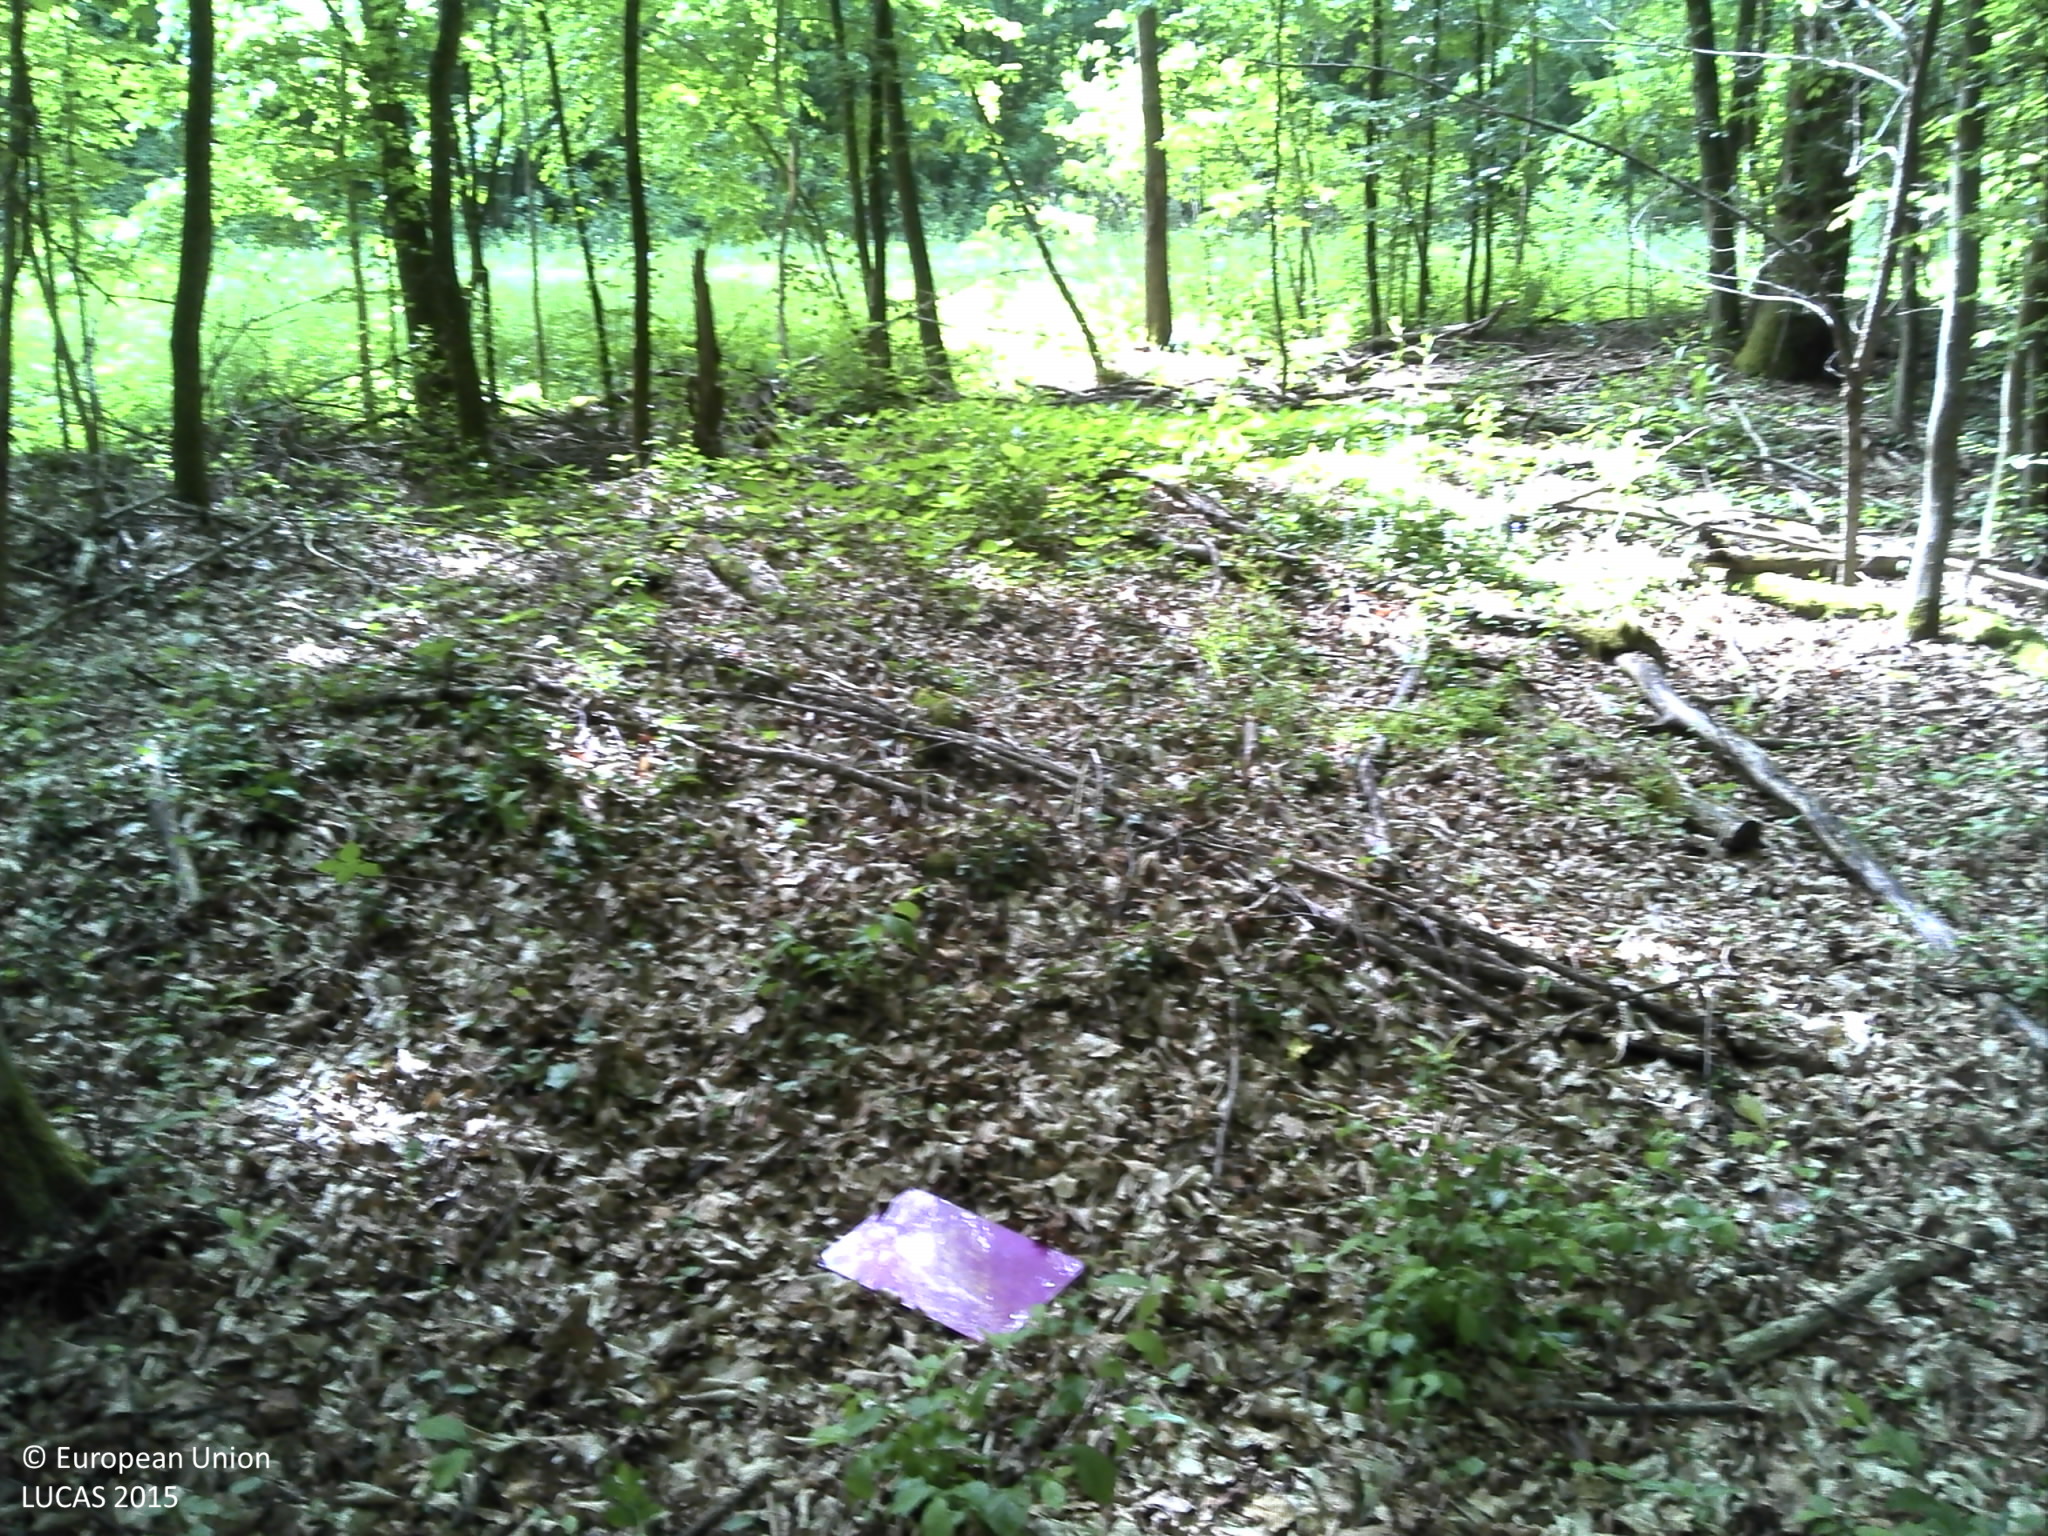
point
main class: Woodland
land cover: Broadleaved woodland
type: mesophytic deciduous forest
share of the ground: > 75 %
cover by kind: broadleaved forest trees 100 %
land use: Forestry
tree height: > 5 m
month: May
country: HR
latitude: 45.1516
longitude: 18.6166
